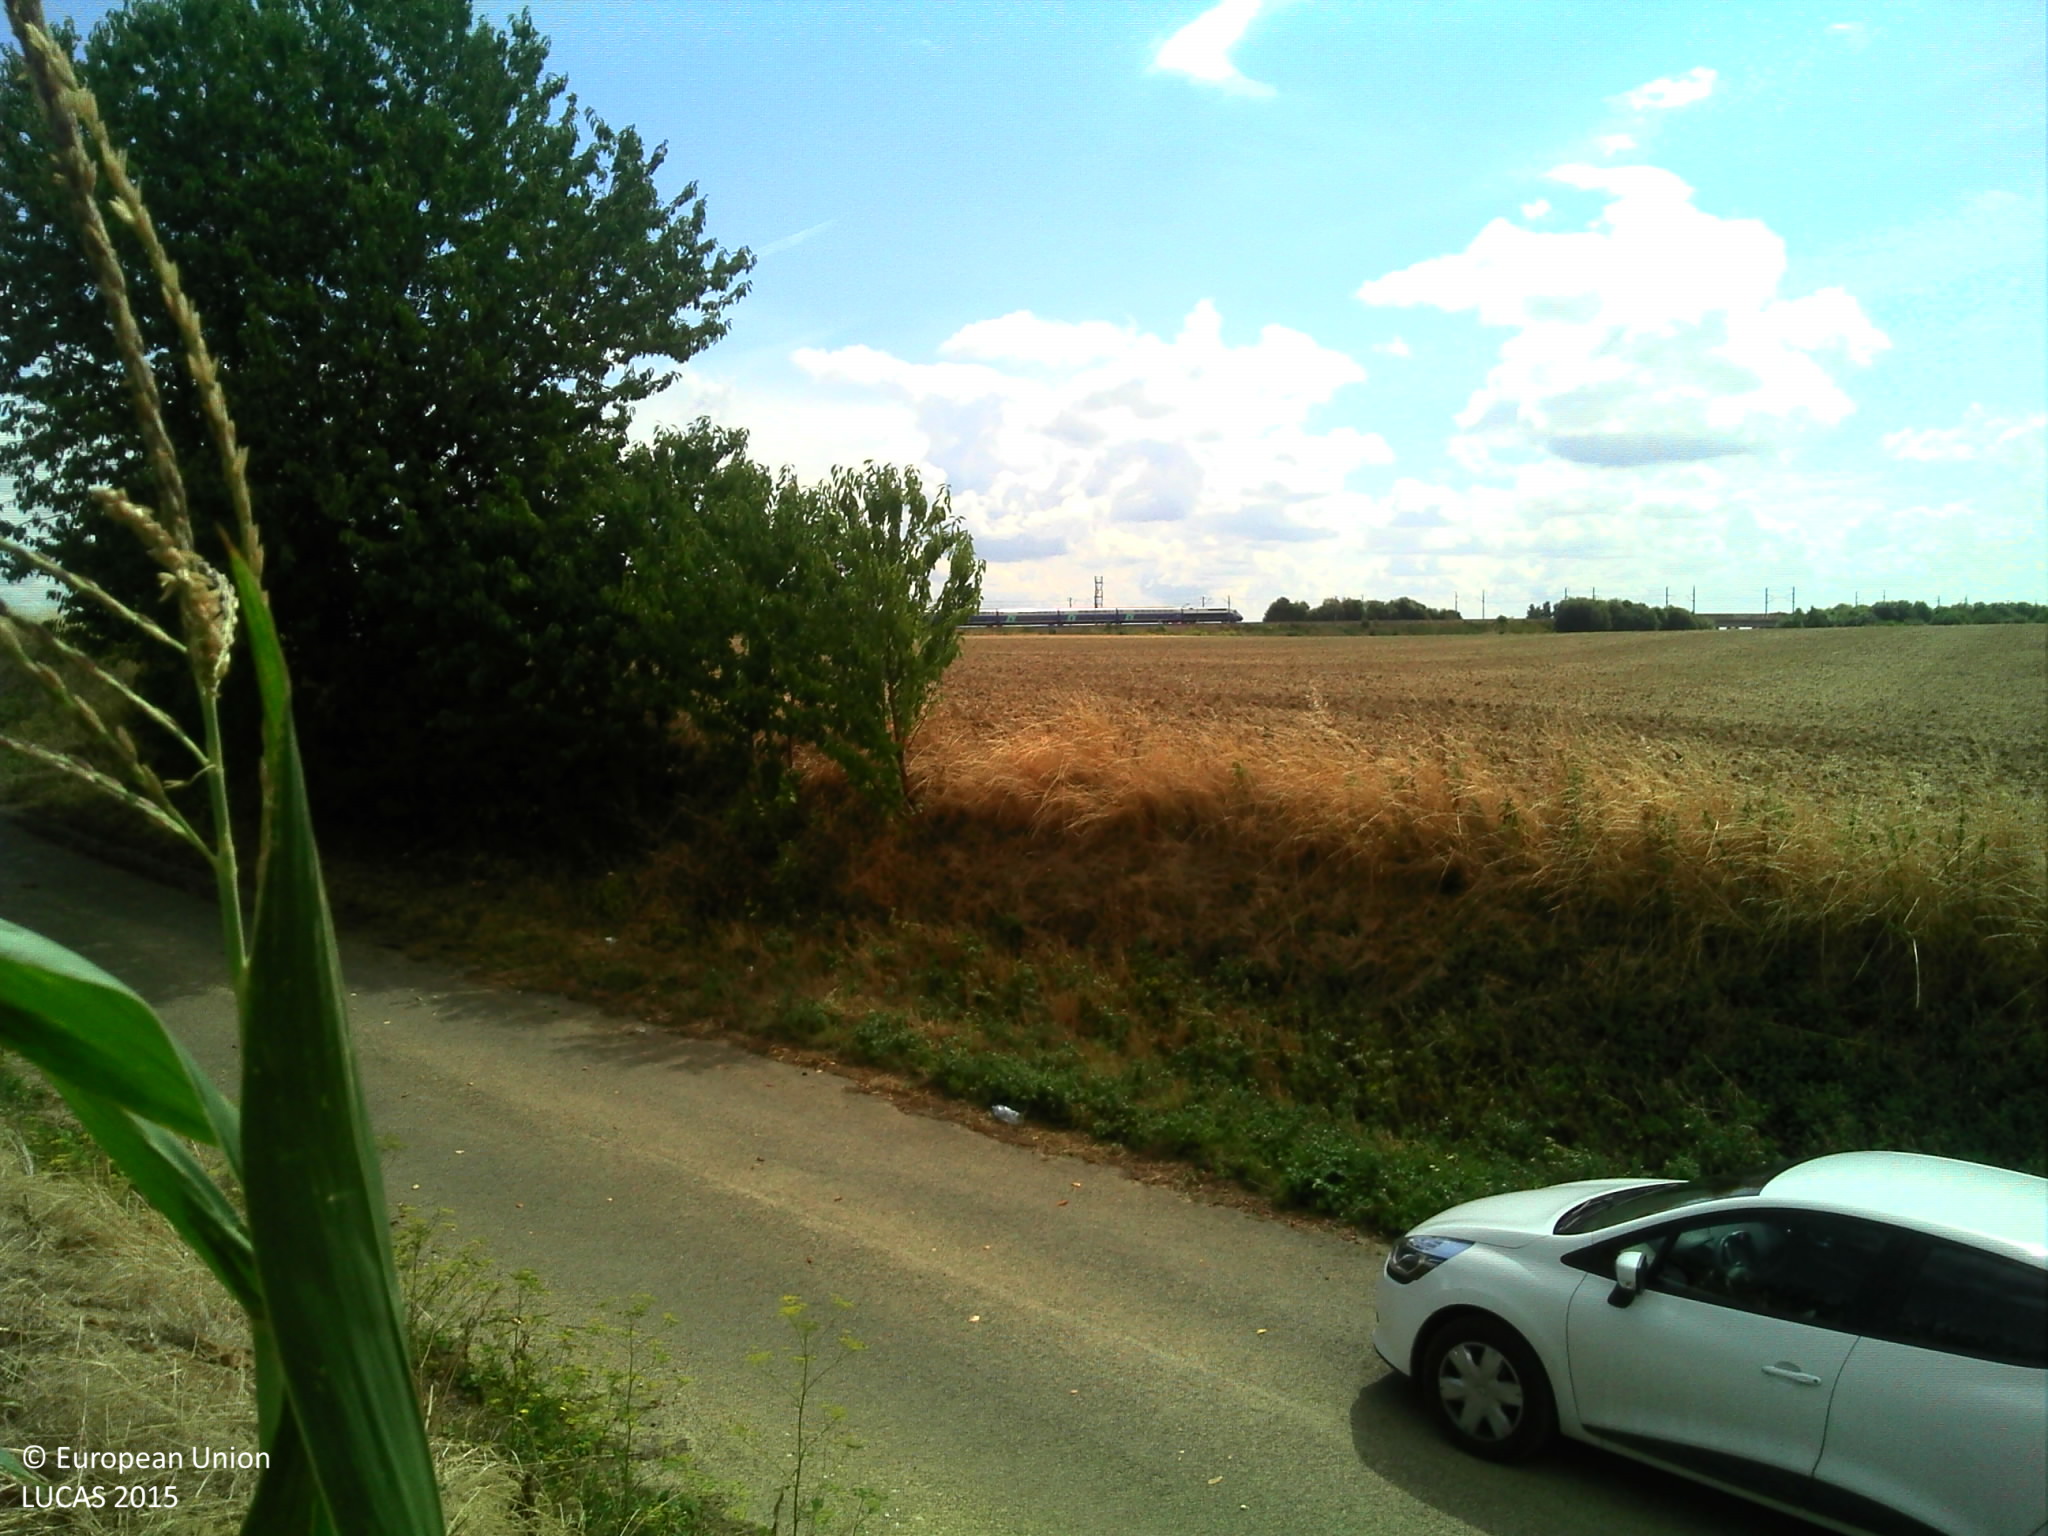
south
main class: Cropland
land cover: Maize
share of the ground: > 75 %
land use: Agriculture (excluding fallow land and kitchen gardens)
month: August
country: FR
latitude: 49.0343
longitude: 2.5065
